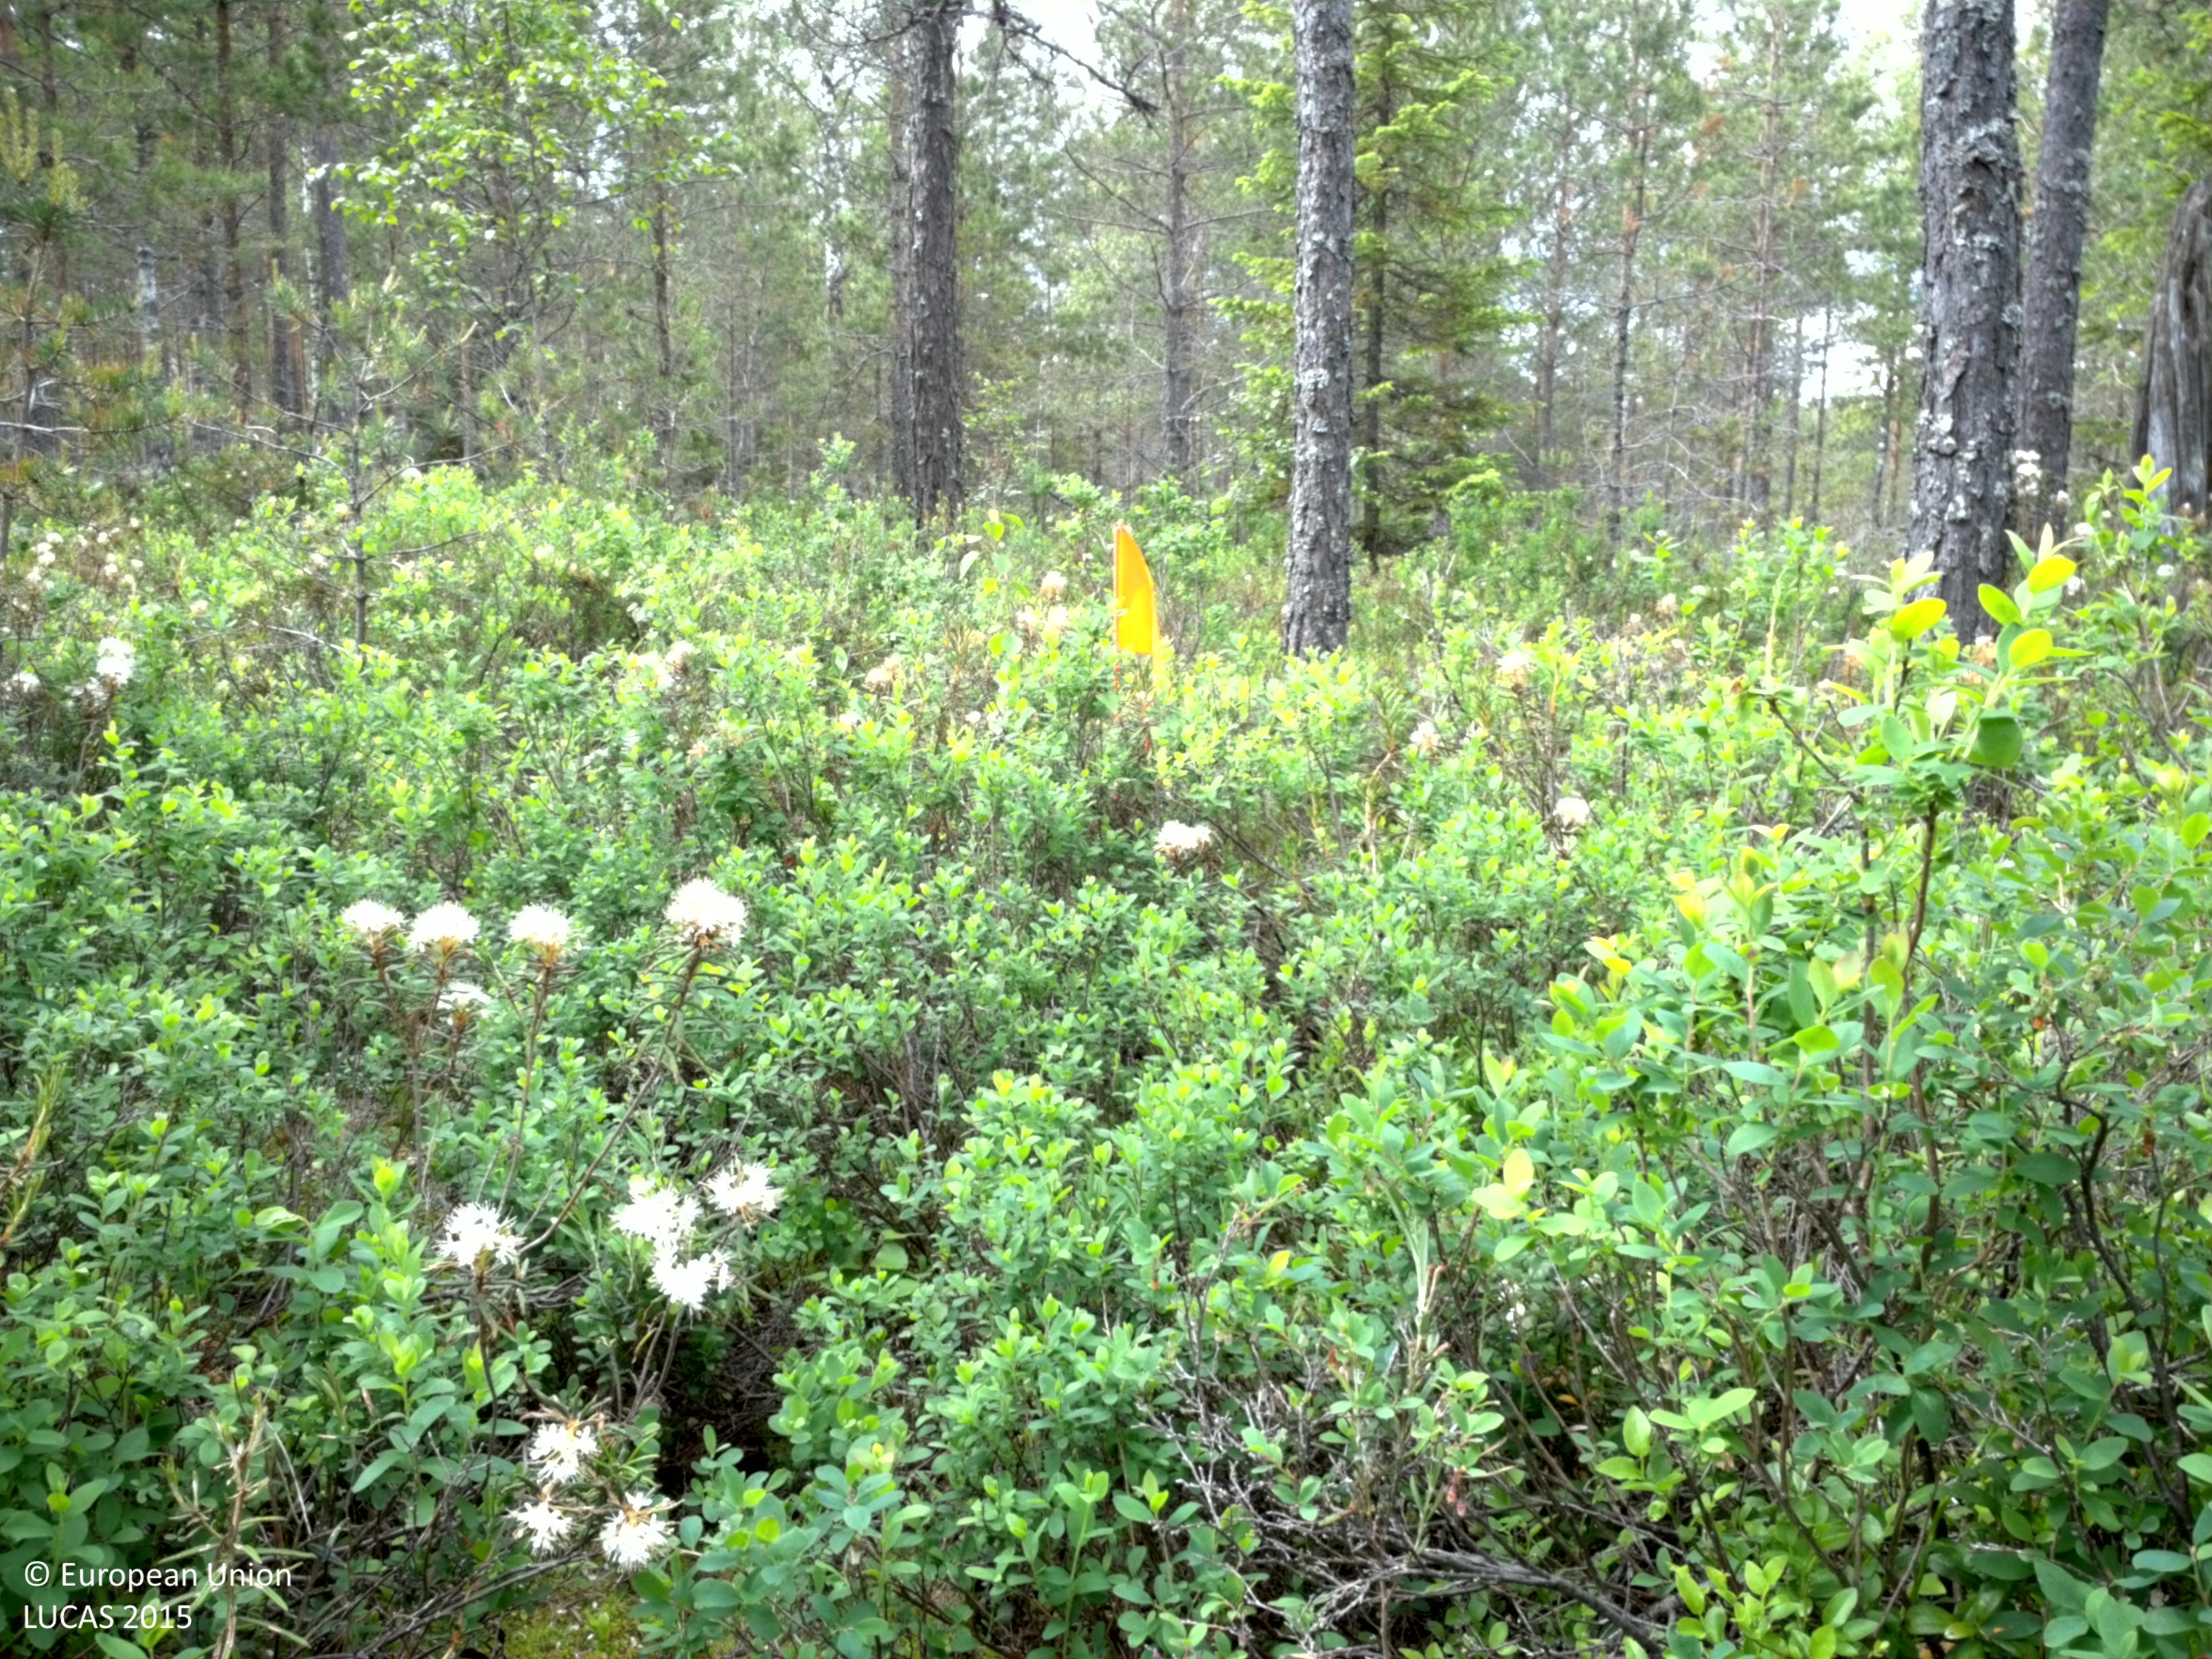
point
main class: Woodland
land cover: Pine dominated coniferous woodland
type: boreal forest
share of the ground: 25 - 50 %
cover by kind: coniferous forest trees 45 %, lichens and mosses 30 %, shrubs 20 %, broadleaved forest trees 5 %
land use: Forestry
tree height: > 5 m
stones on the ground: < 10 %
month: June
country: SE
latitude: 59.9977
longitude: 17.1817
